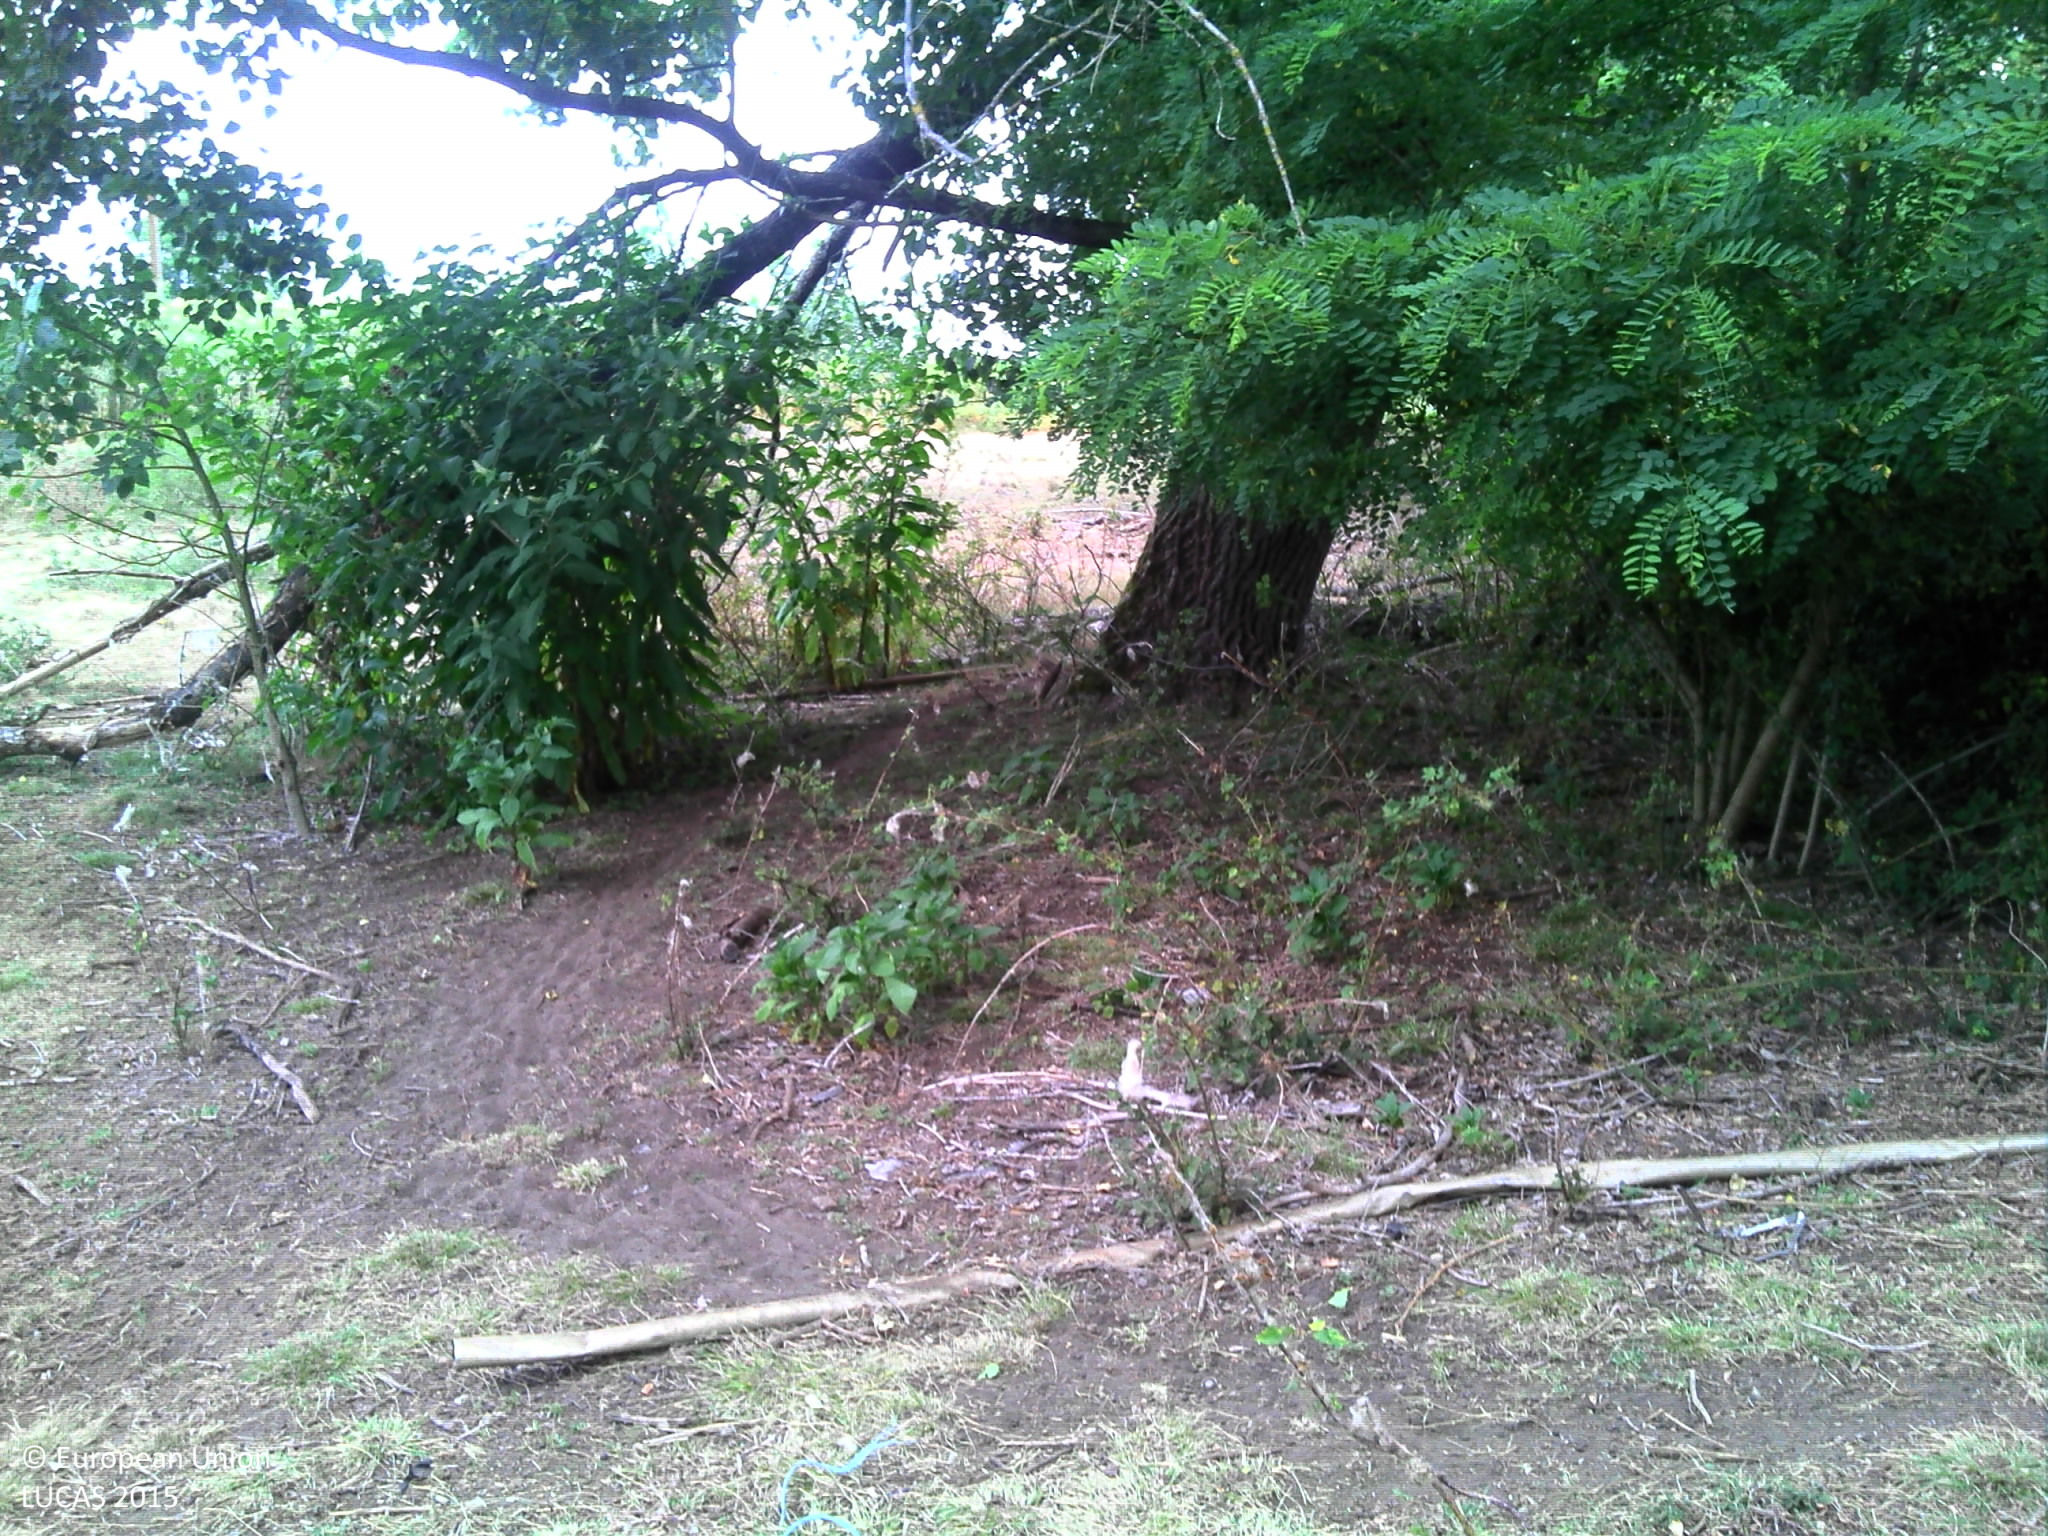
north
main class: Grassland
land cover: Grassland with sparse tree/shrub cover
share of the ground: > 75 %
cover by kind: herbaceous plants 95 %, broadleaved forest trees 5 %
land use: Residential
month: July
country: FR
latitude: 44.0896
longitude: -0.8449
